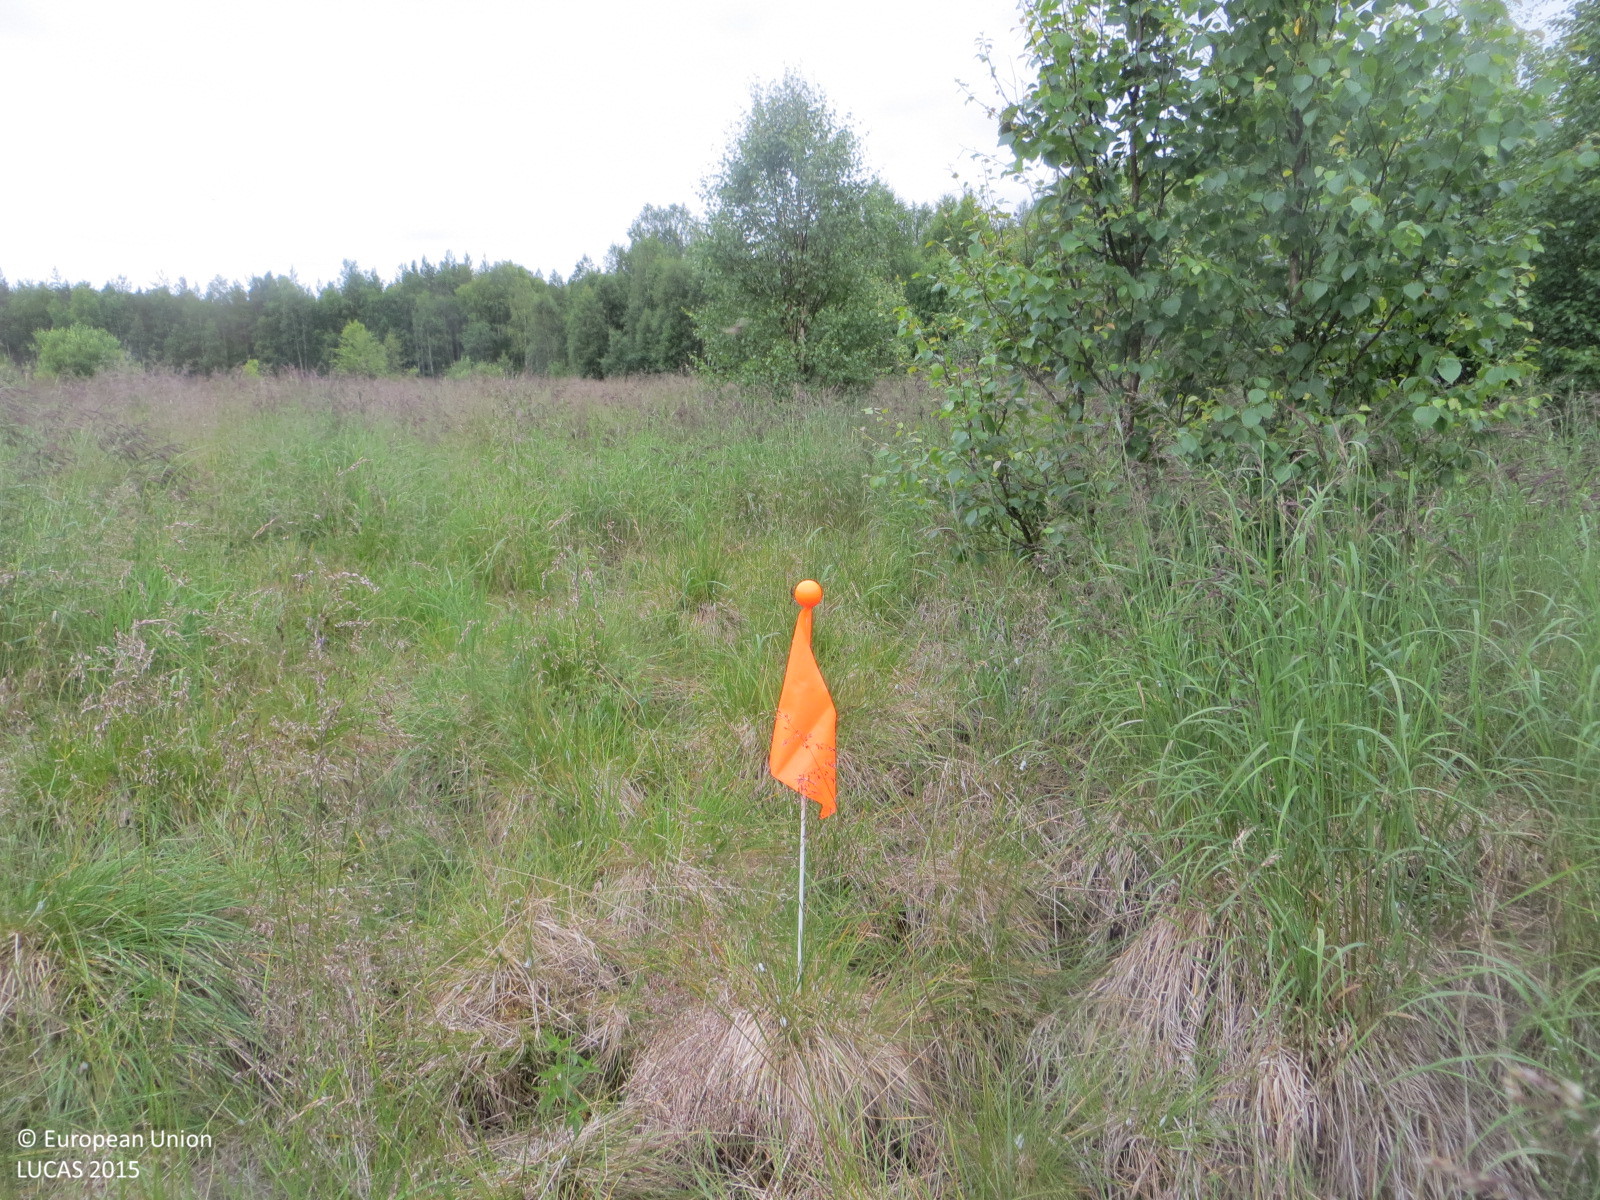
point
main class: Grassland
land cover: Spontaneously vegetated surfaces
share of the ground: > 75 %
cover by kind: herbaceous plants 100 %
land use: Fallow land
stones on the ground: < 10 %
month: July
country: FI
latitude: 66.3712
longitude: 23.7852
